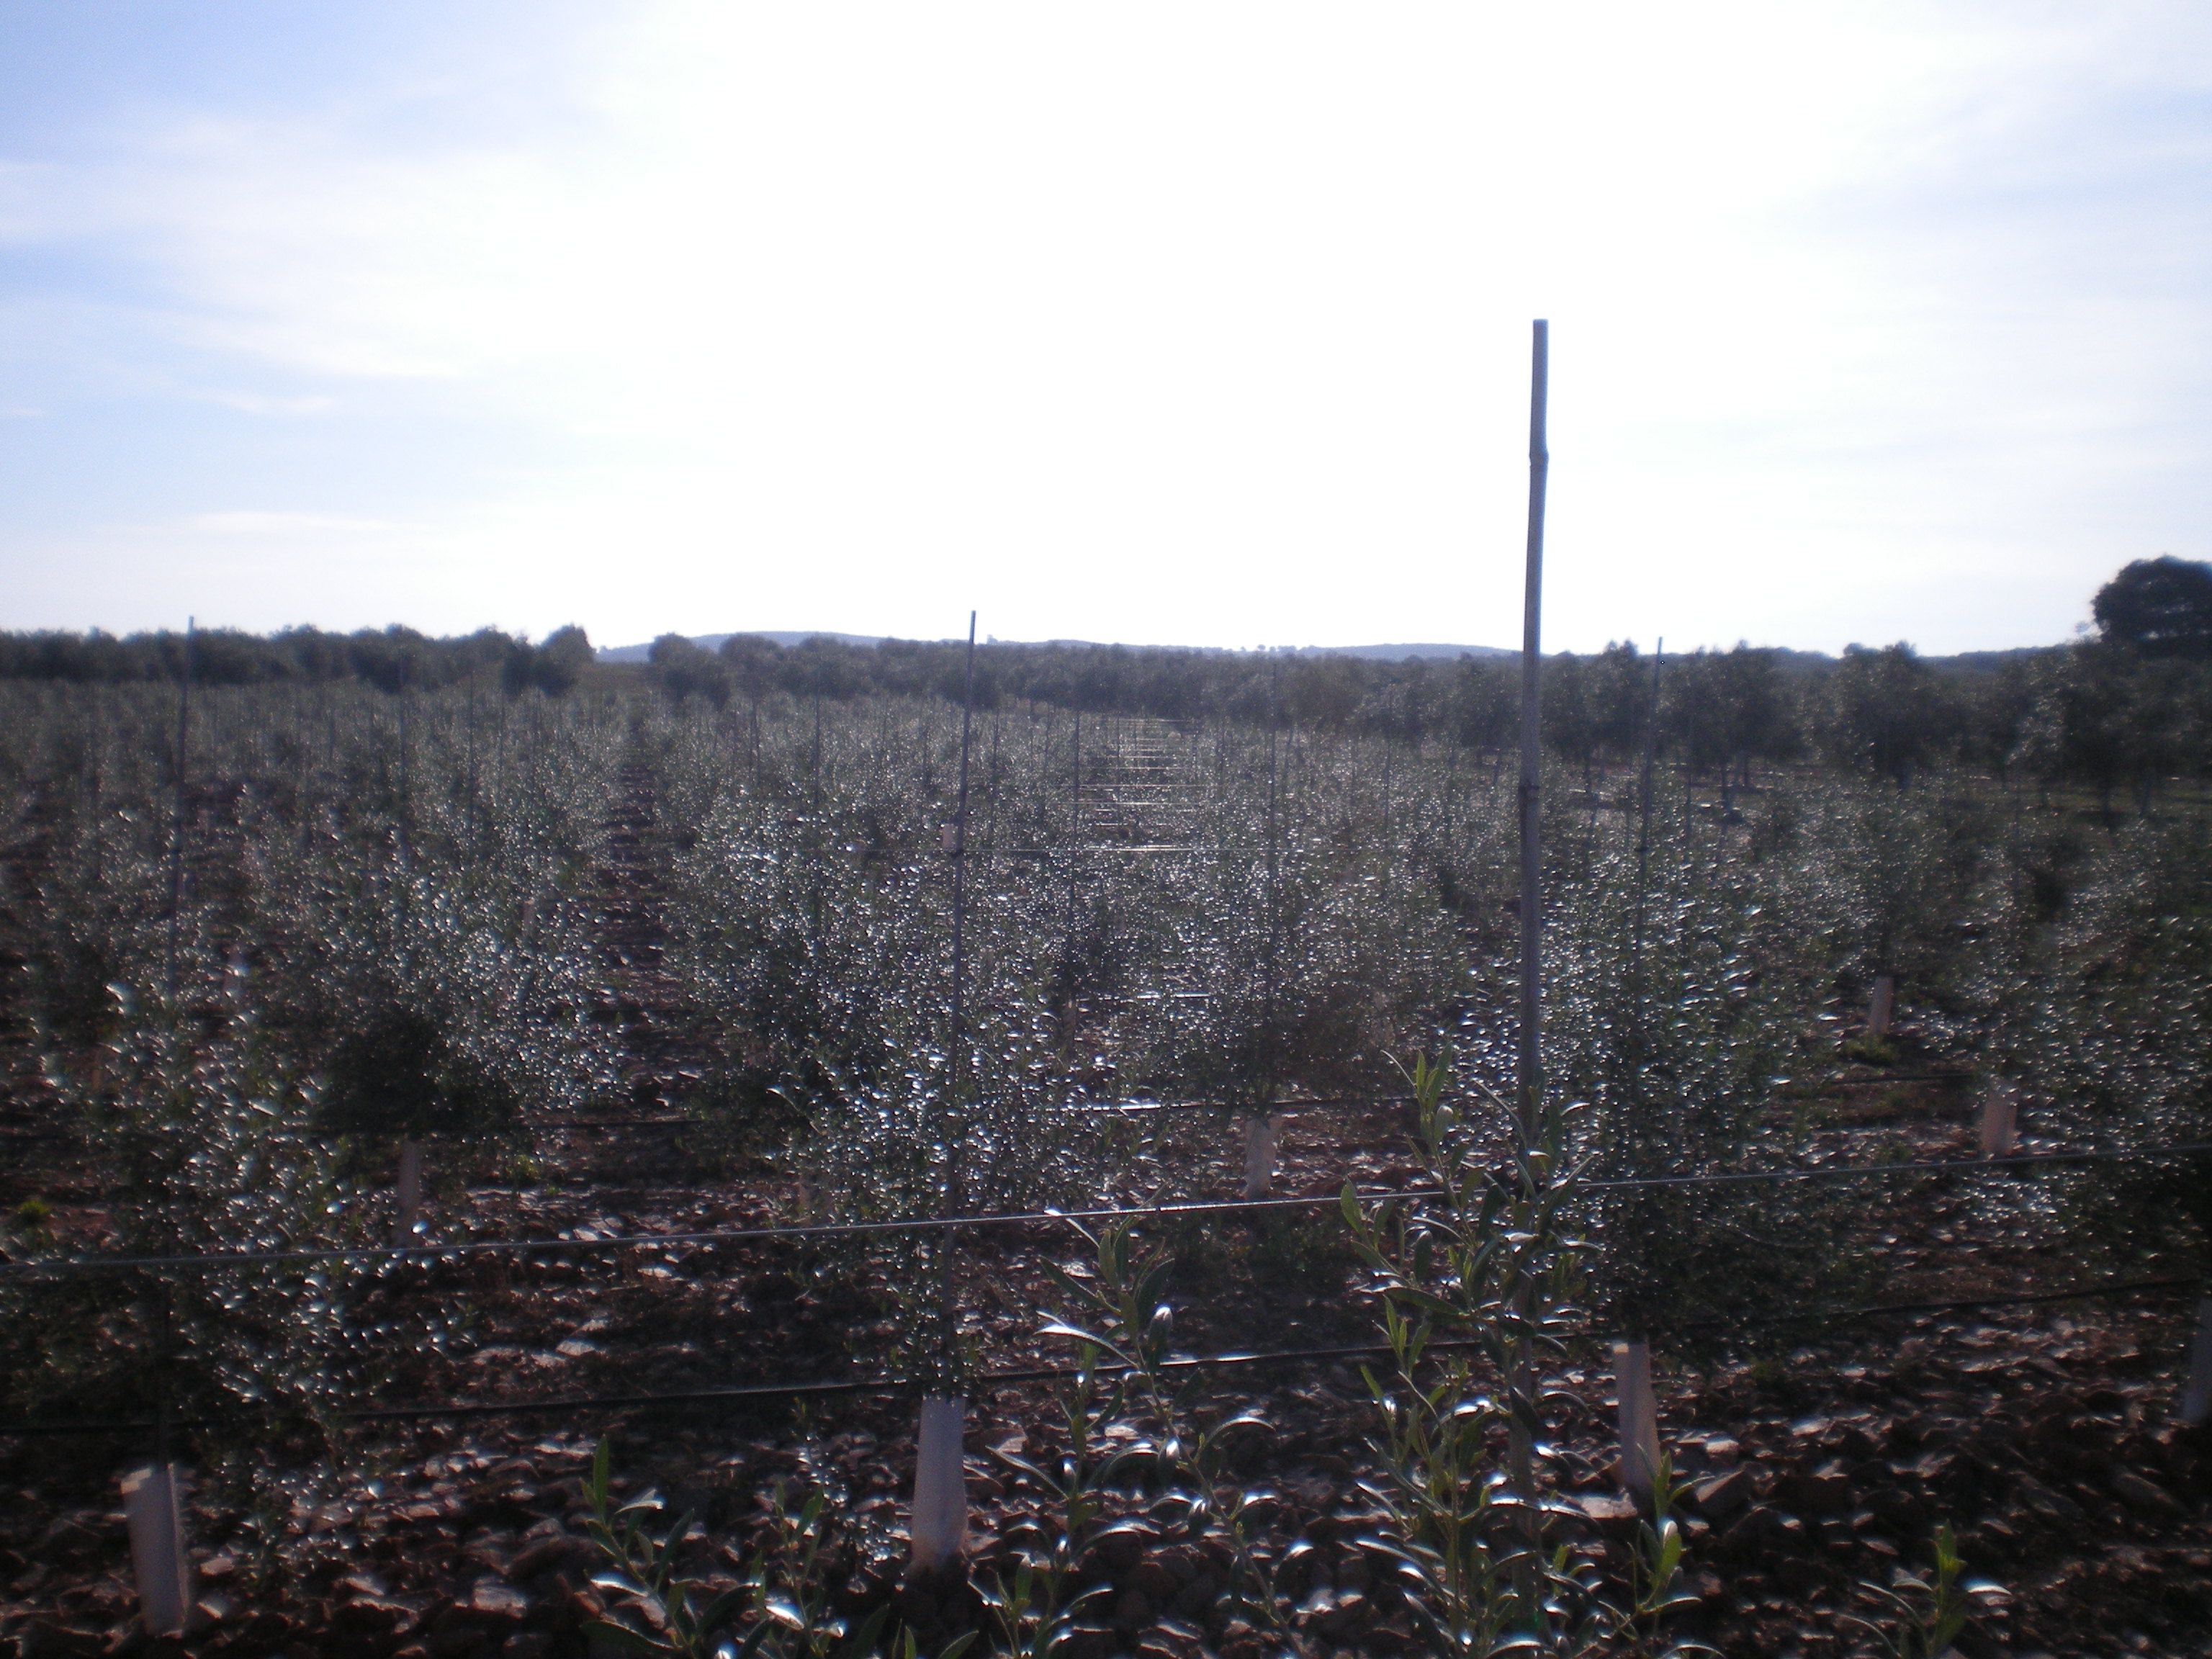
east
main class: Cropland
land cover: Olive groves
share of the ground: 10 - 25 %
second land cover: Other bare soil
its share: > 75 %
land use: Agriculture (excluding fallow land and kitchen gardens)
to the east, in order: Olive groves; Other bare soil
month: April
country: ES
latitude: 38.8781
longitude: -3.5821
